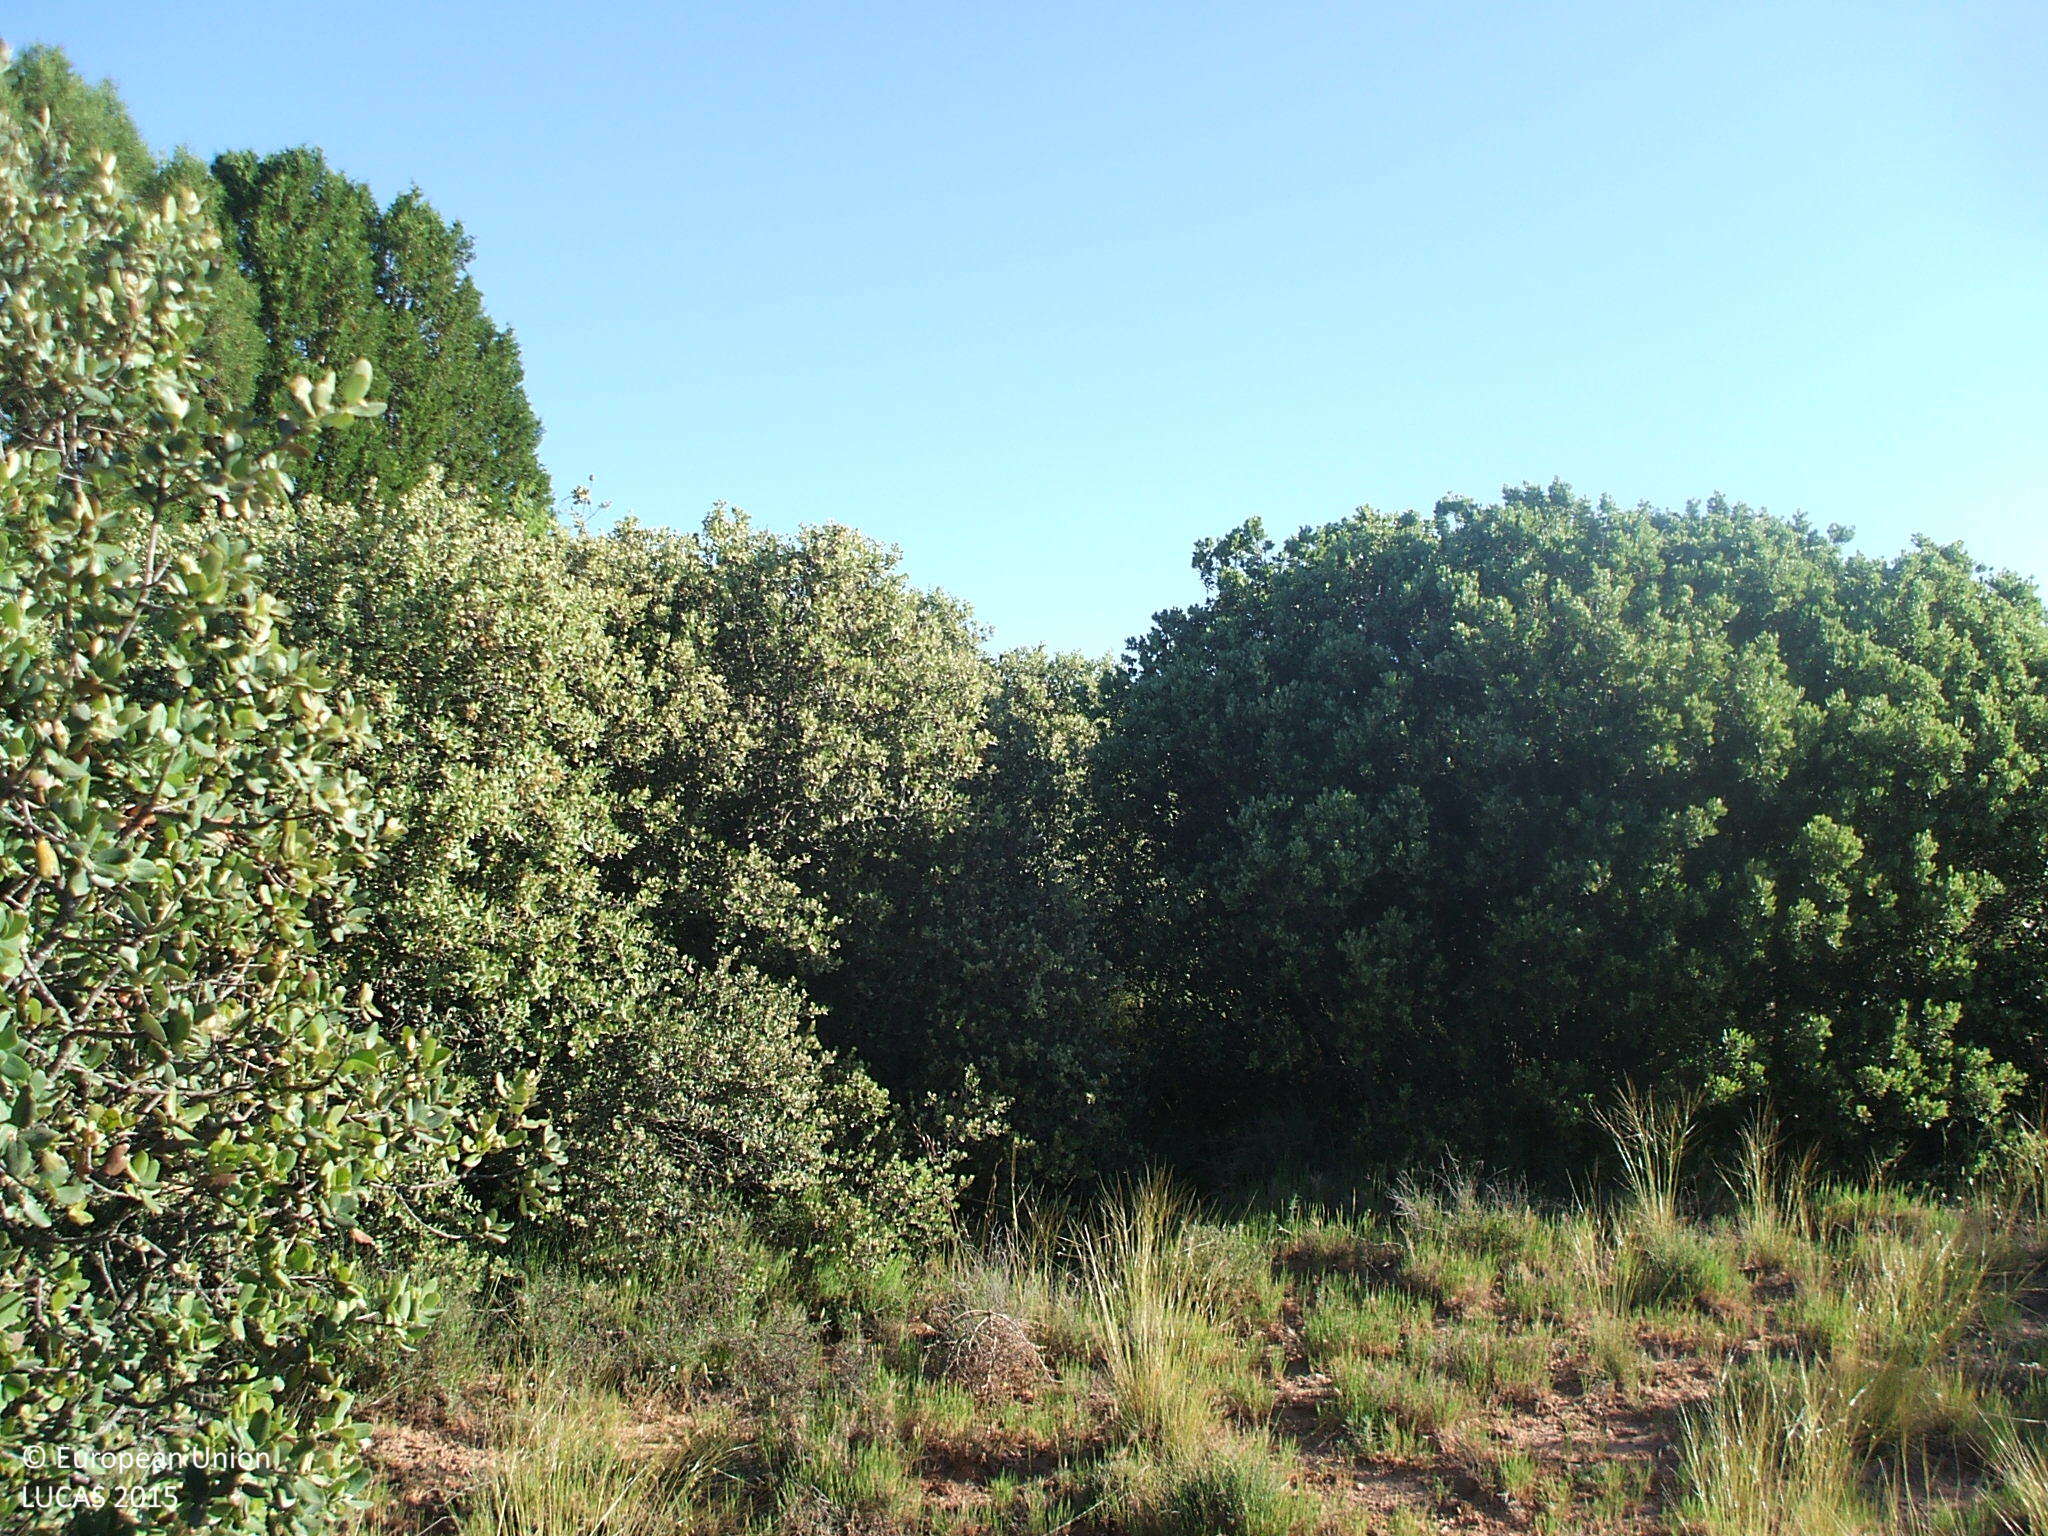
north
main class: Woodland
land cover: Other mixed woodland
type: coniferous forest of the mediterranean region
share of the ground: > 75 %
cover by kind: coniferous forest trees 30 %, broadleaved forest trees 30 %, shrubs 20 %, unconsolidated bare surface 20 %
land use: Semi-natural and natural areas not in use
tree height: > 5 m
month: May
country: ES
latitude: 40.2005
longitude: -0.7796
